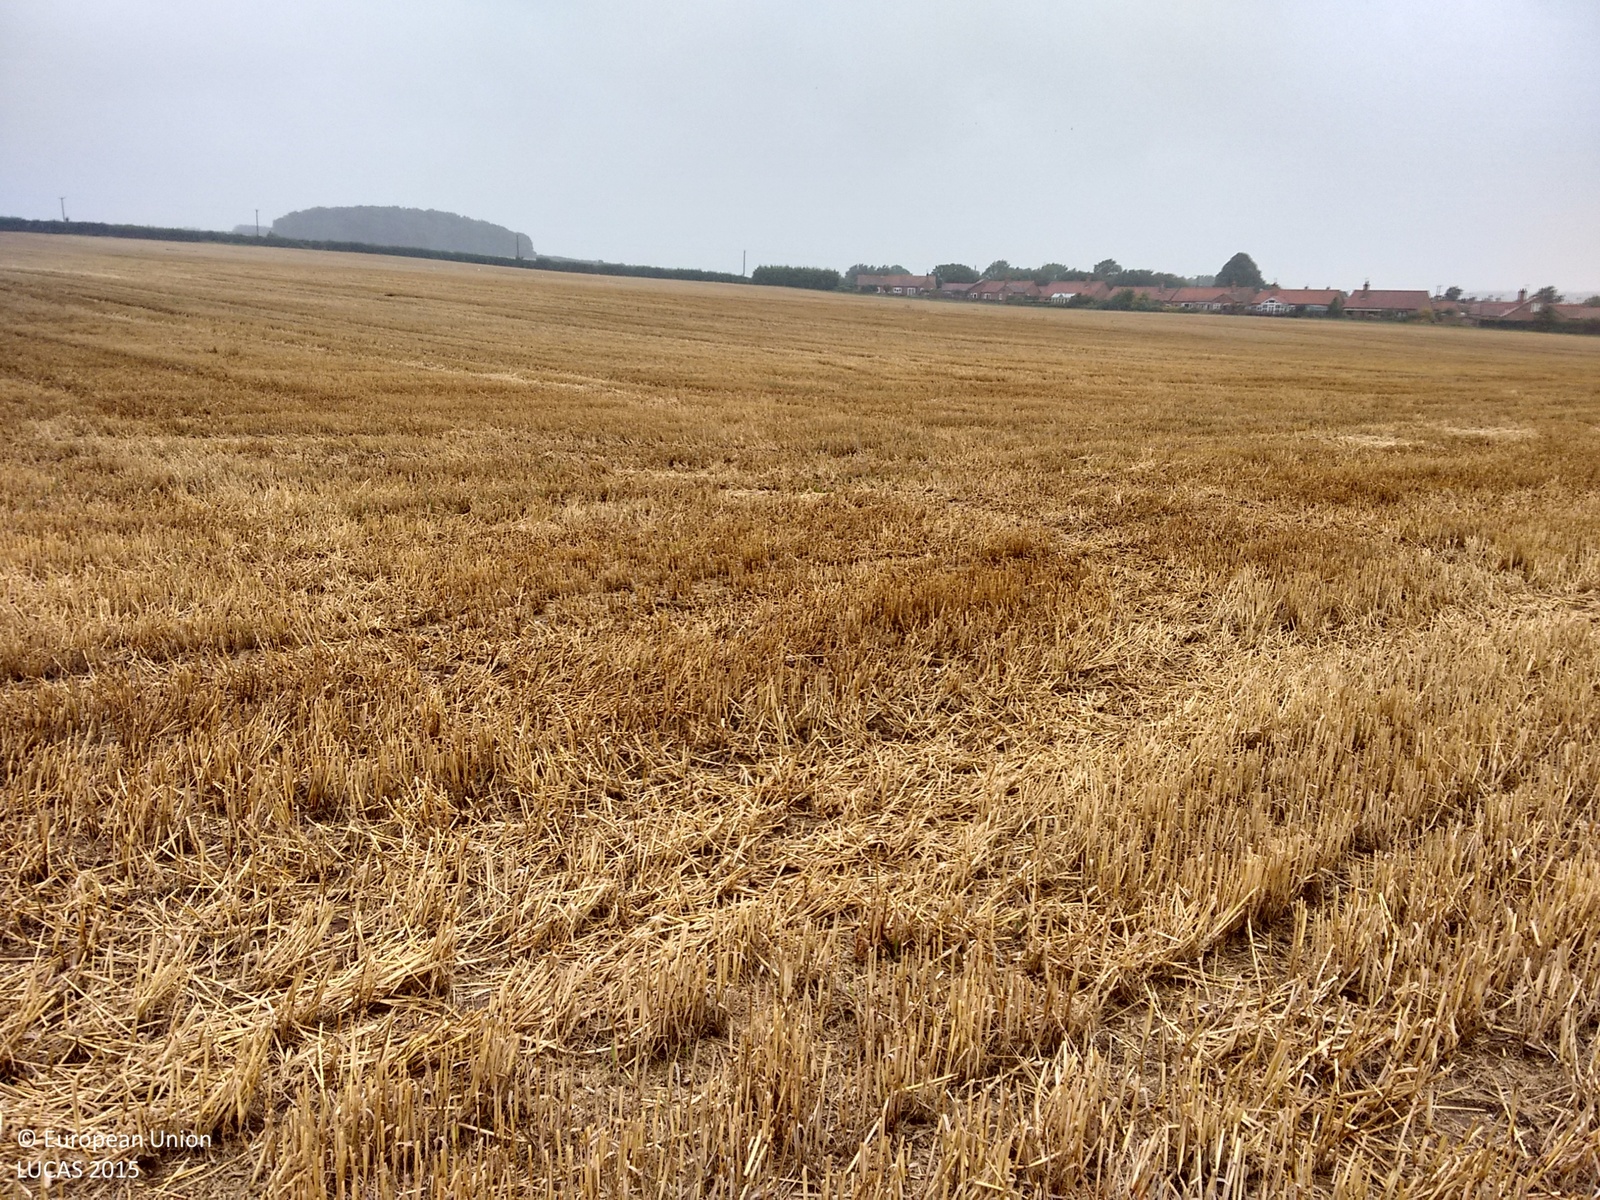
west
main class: Cropland
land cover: Common wheat
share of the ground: > 75 %
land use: Agriculture (excluding fallow land and kitchen gardens)
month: August
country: GB
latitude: 52.9375
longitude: 0.7350
